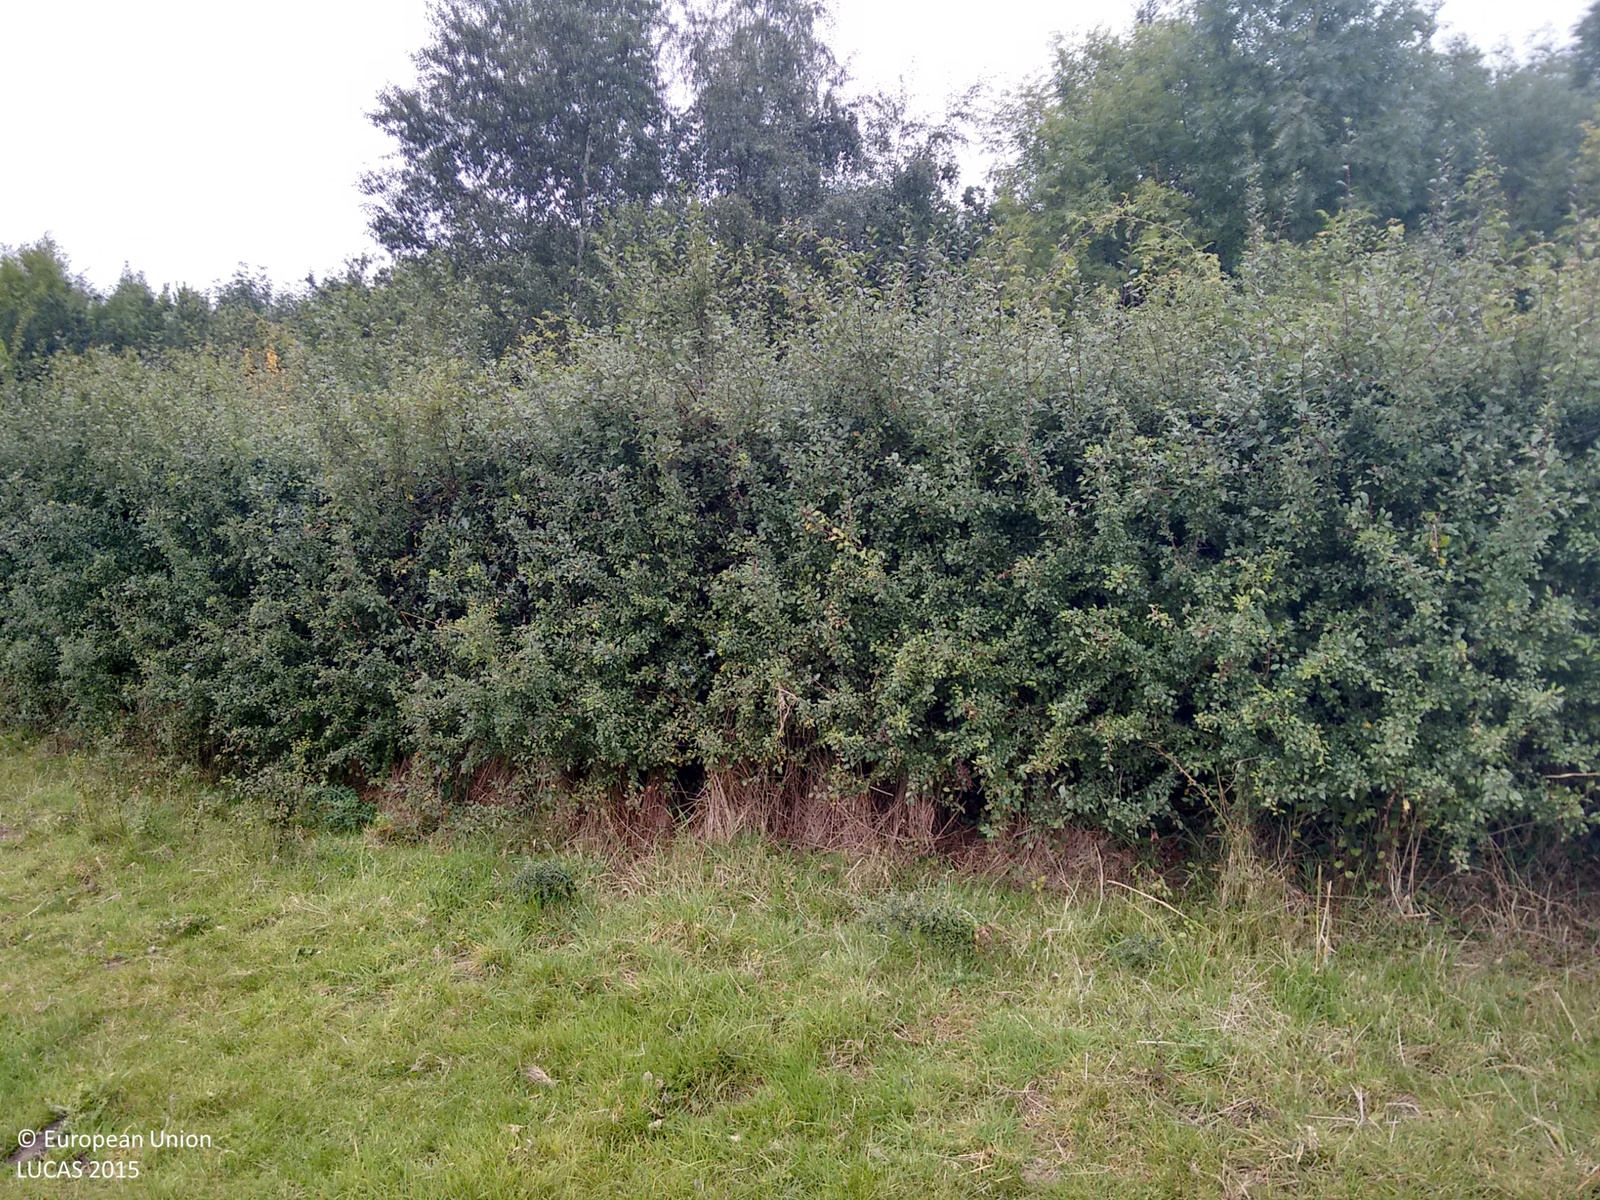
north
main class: Woodland
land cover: Broadleaved woodland
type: mesophytic deciduous forest
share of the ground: > 75 %
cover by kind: broadleaved forest trees 100 %
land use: Forestry
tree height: > 5 m
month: September
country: GB
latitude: 52.7524
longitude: -2.8283
